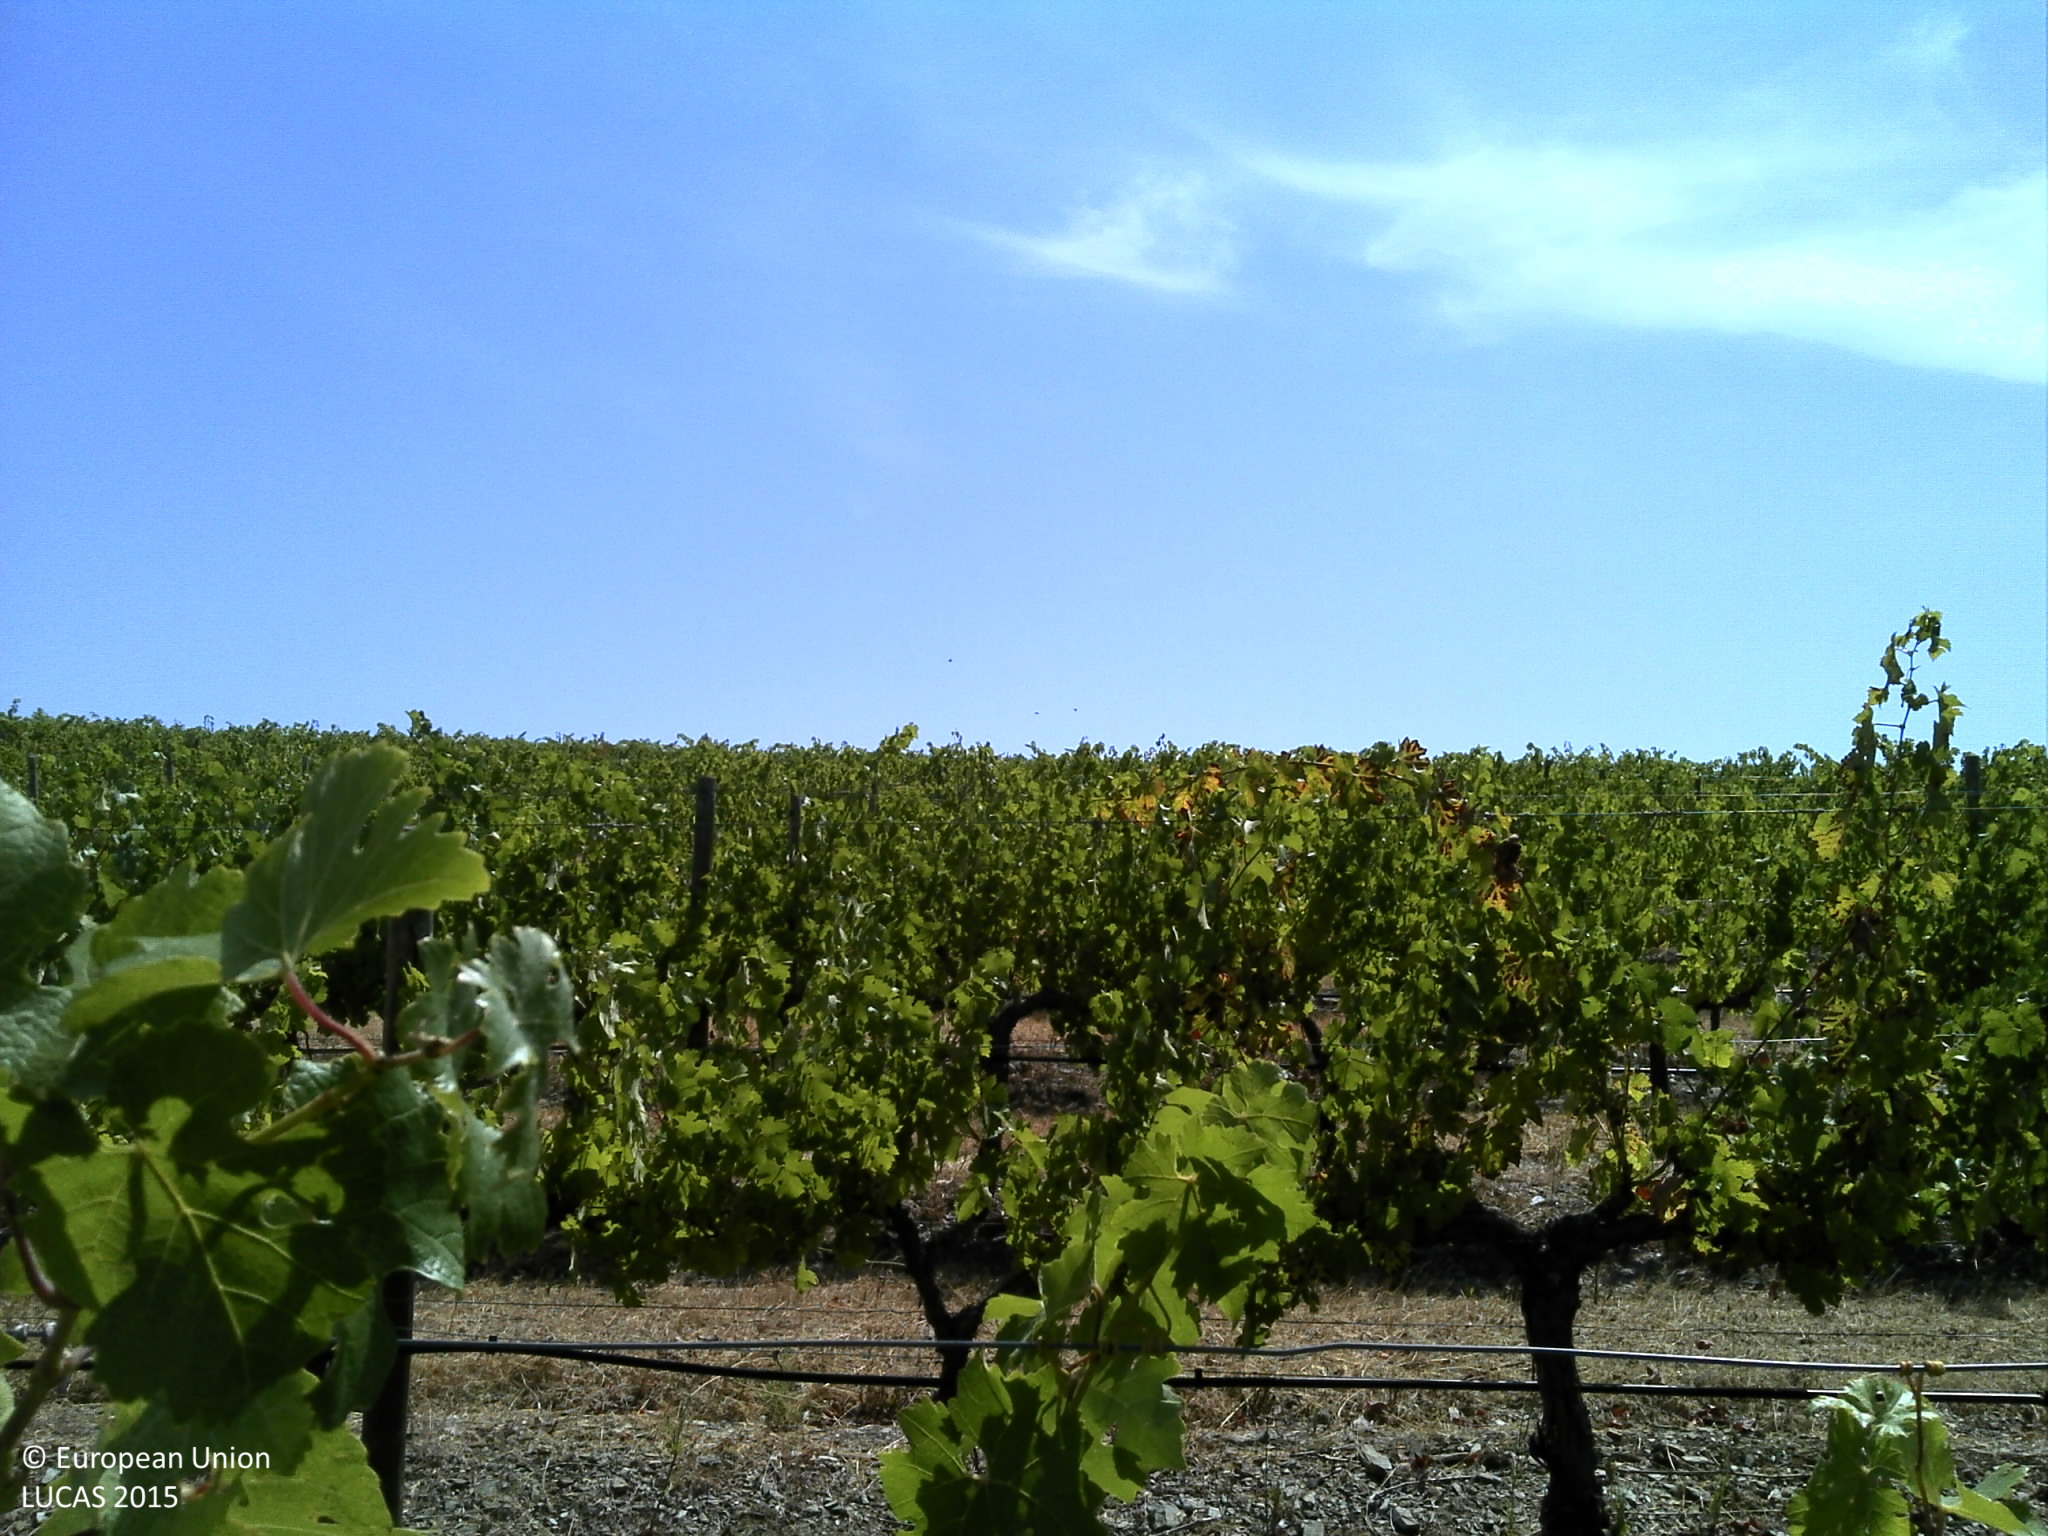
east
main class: Cropland
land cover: Vineyards
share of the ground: 25 - 50 %
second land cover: Grassland without tree/shrub cover
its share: 25 - 50 %
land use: Agriculture (excluding fallow land and kitchen gardens)
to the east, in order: Vineyards; Grassland without tree/shrub cover; Vineyards; Tracks; Oats
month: July
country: PT
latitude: 38.5037
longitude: -7.6570
